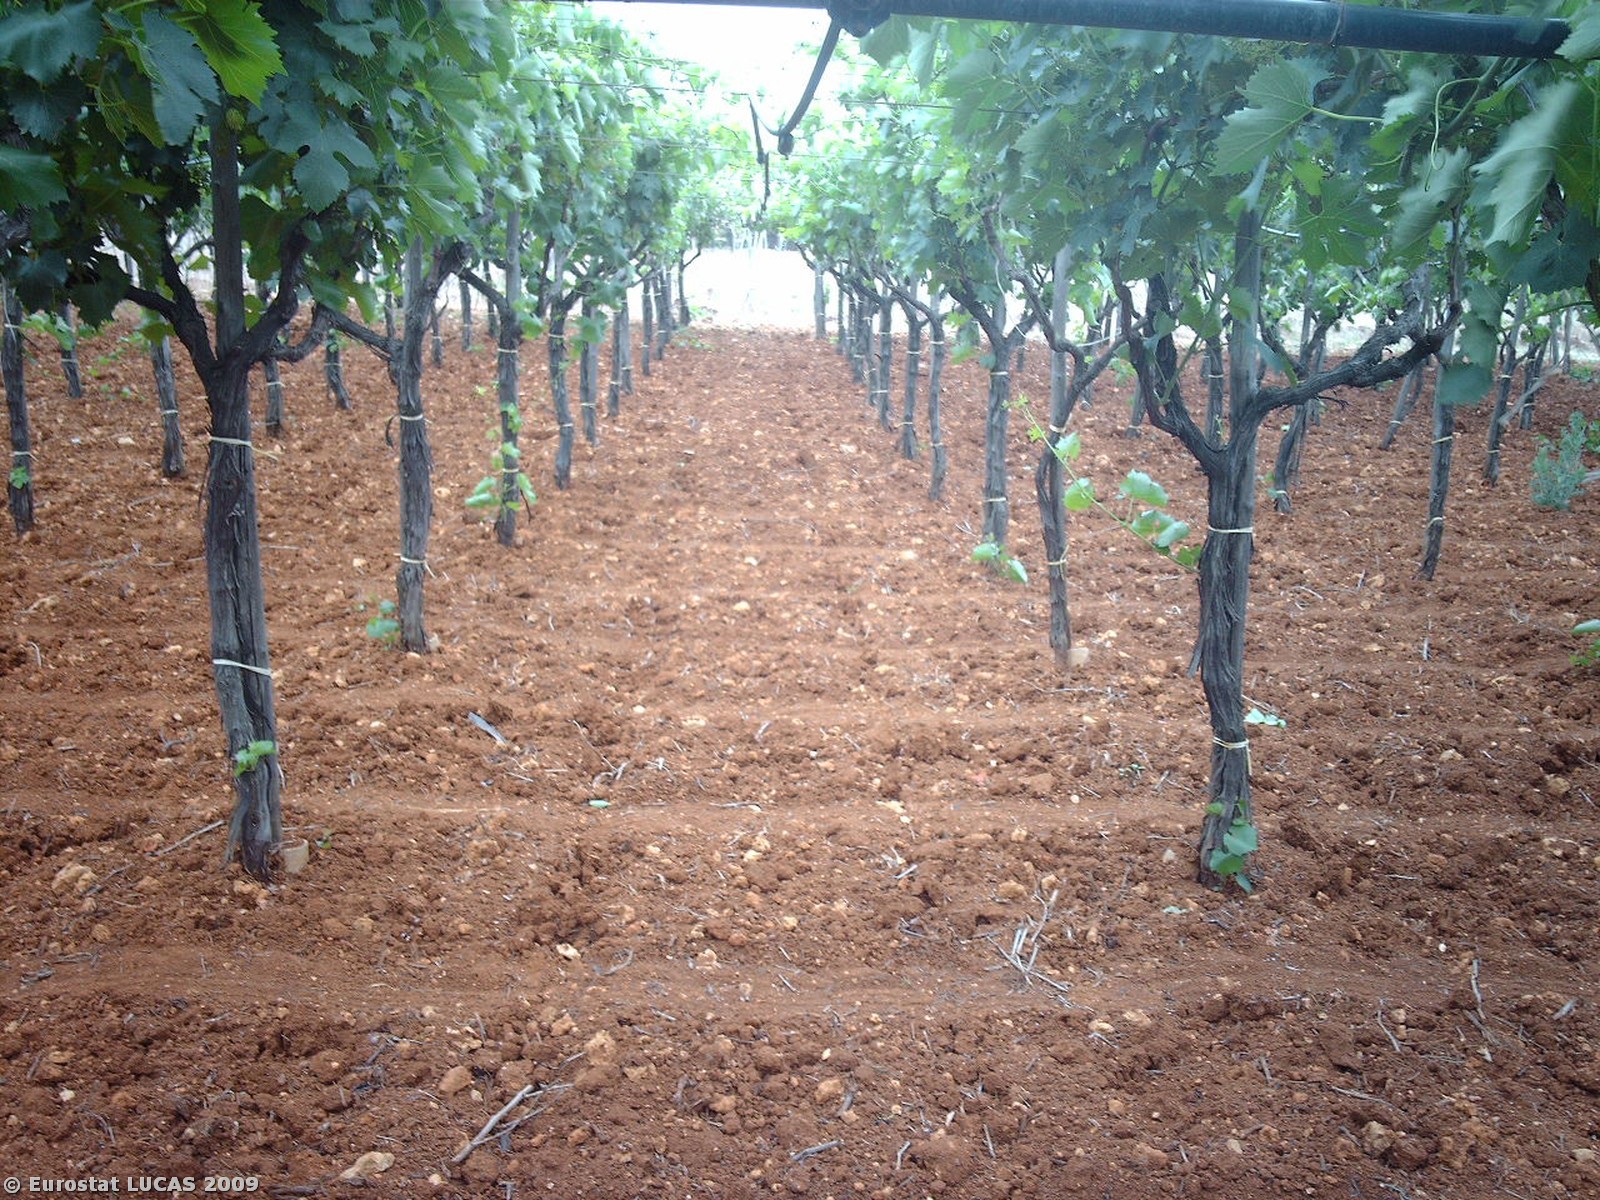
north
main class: Cropland
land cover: Vineyards
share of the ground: > 75 %
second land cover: Bare land
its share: 50 - 75 %
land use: Agriculture (excluding fallow land and kitchen gardens)
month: June
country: IT
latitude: 40.9430
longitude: 16.9984
